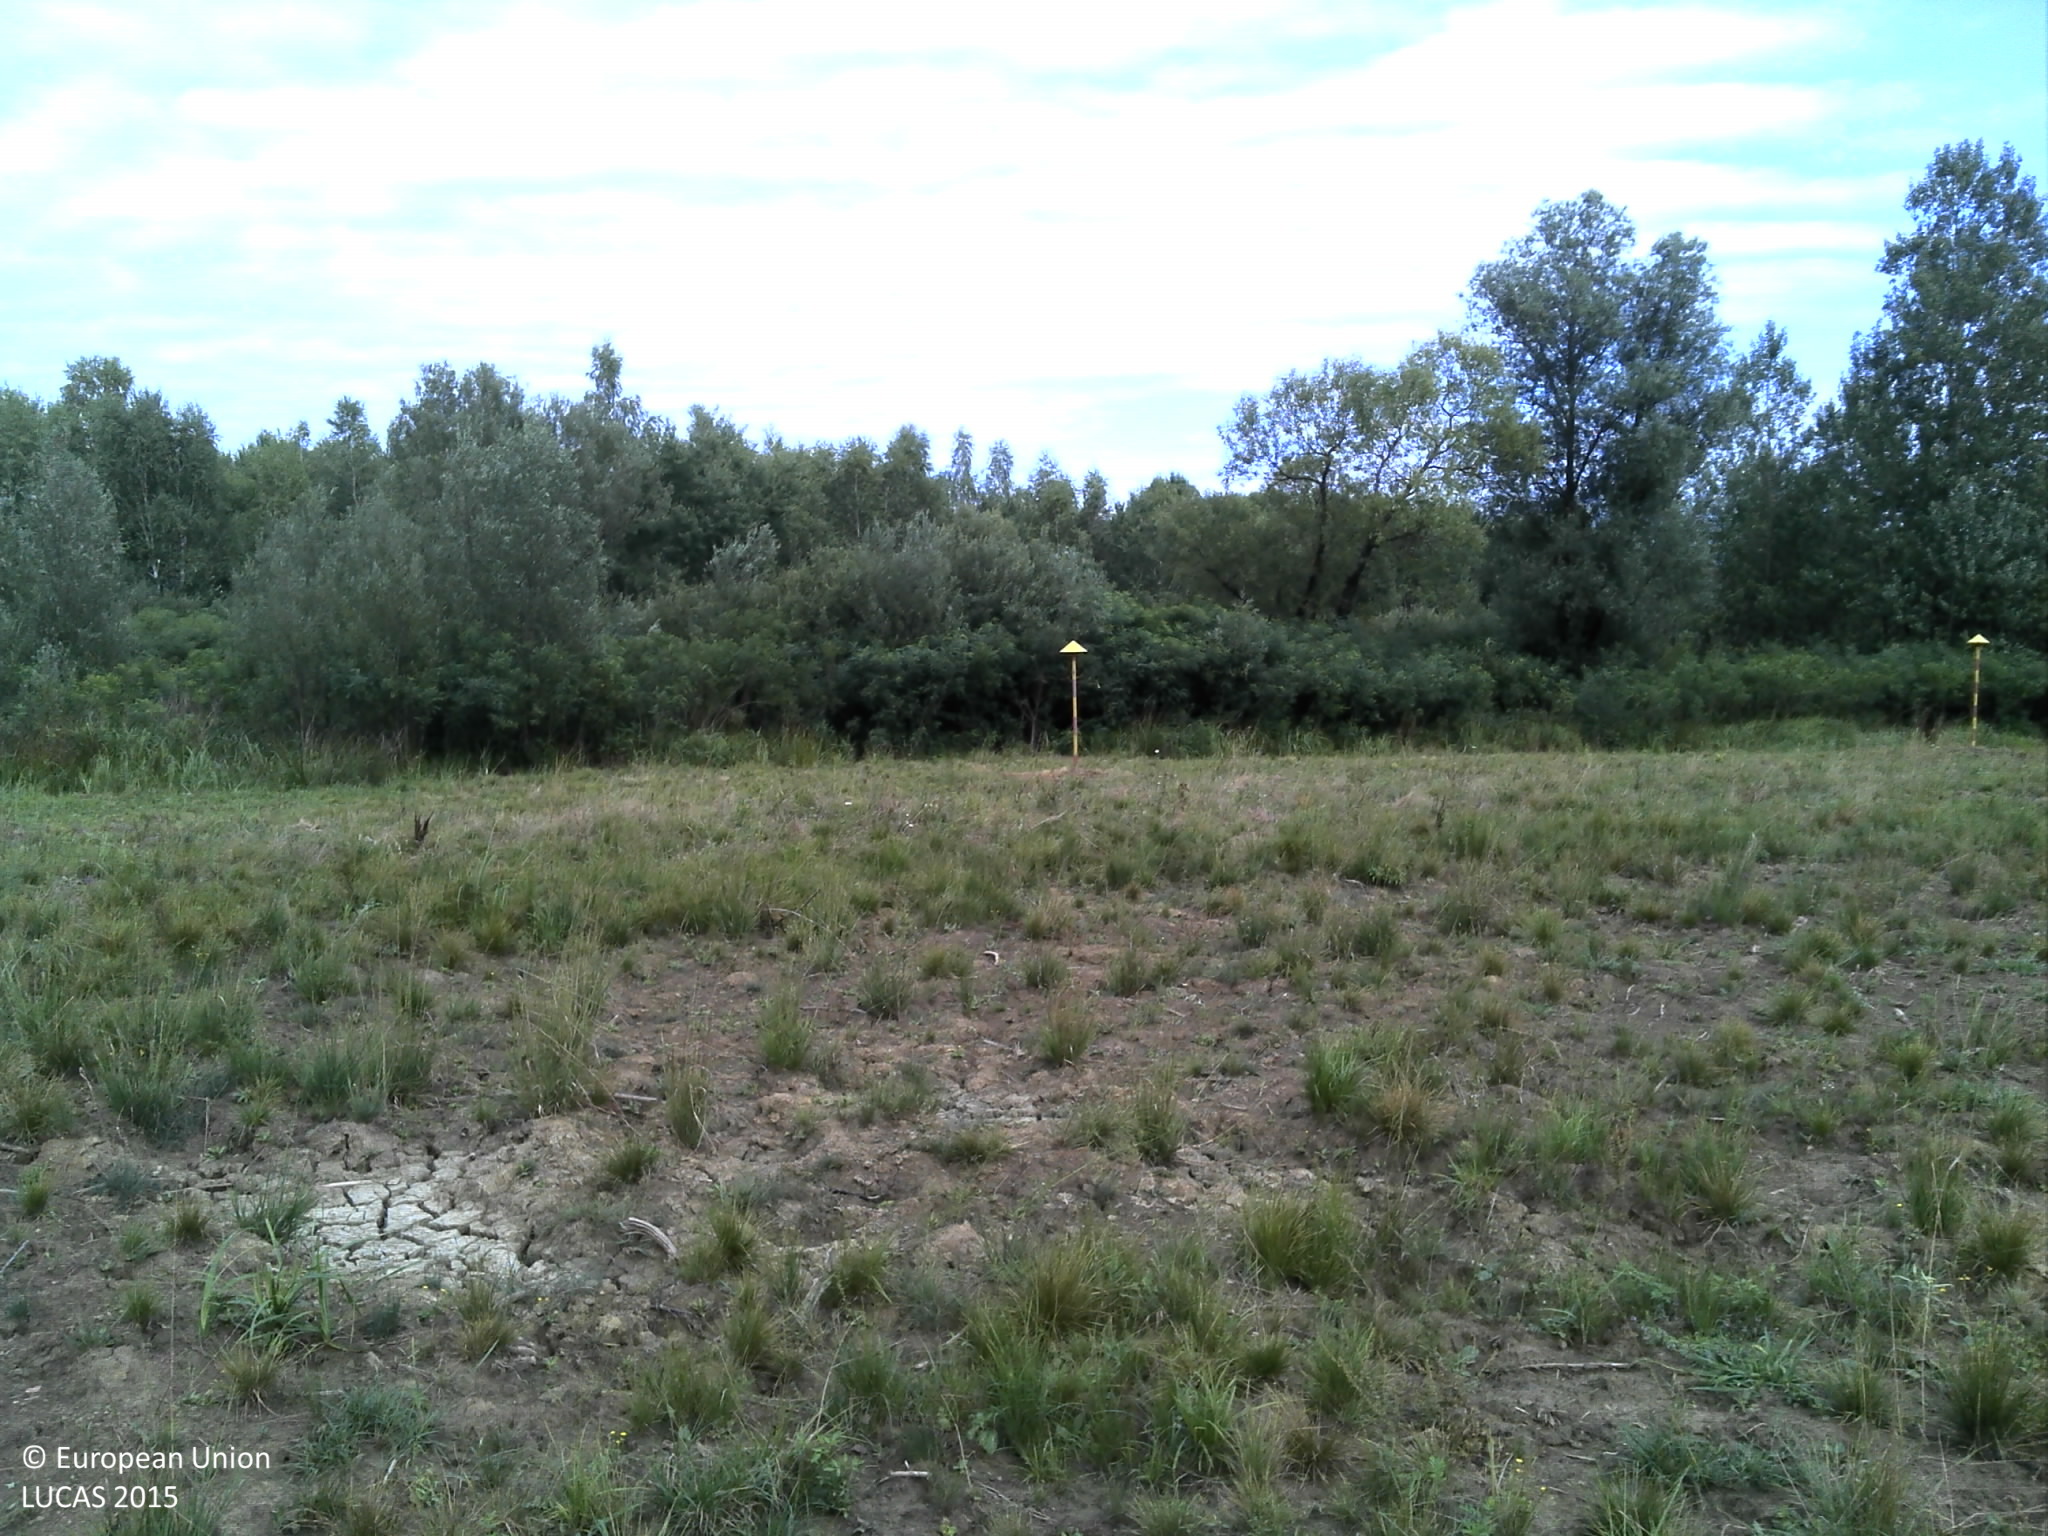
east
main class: Grassland
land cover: Grassland with sparse tree/shrub cover
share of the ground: > 75 %
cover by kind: herbaceous plants 90 %, broadleaved forest trees 5 %, shrubs 5 %
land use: Semi-natural and natural areas not in use
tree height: < 5 m
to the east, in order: Grassland with sparse tree/shrub cover; Ditches and canals; Shrubland with sparse tree cover
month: July
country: HR
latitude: 45.6082
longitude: 16.5508
